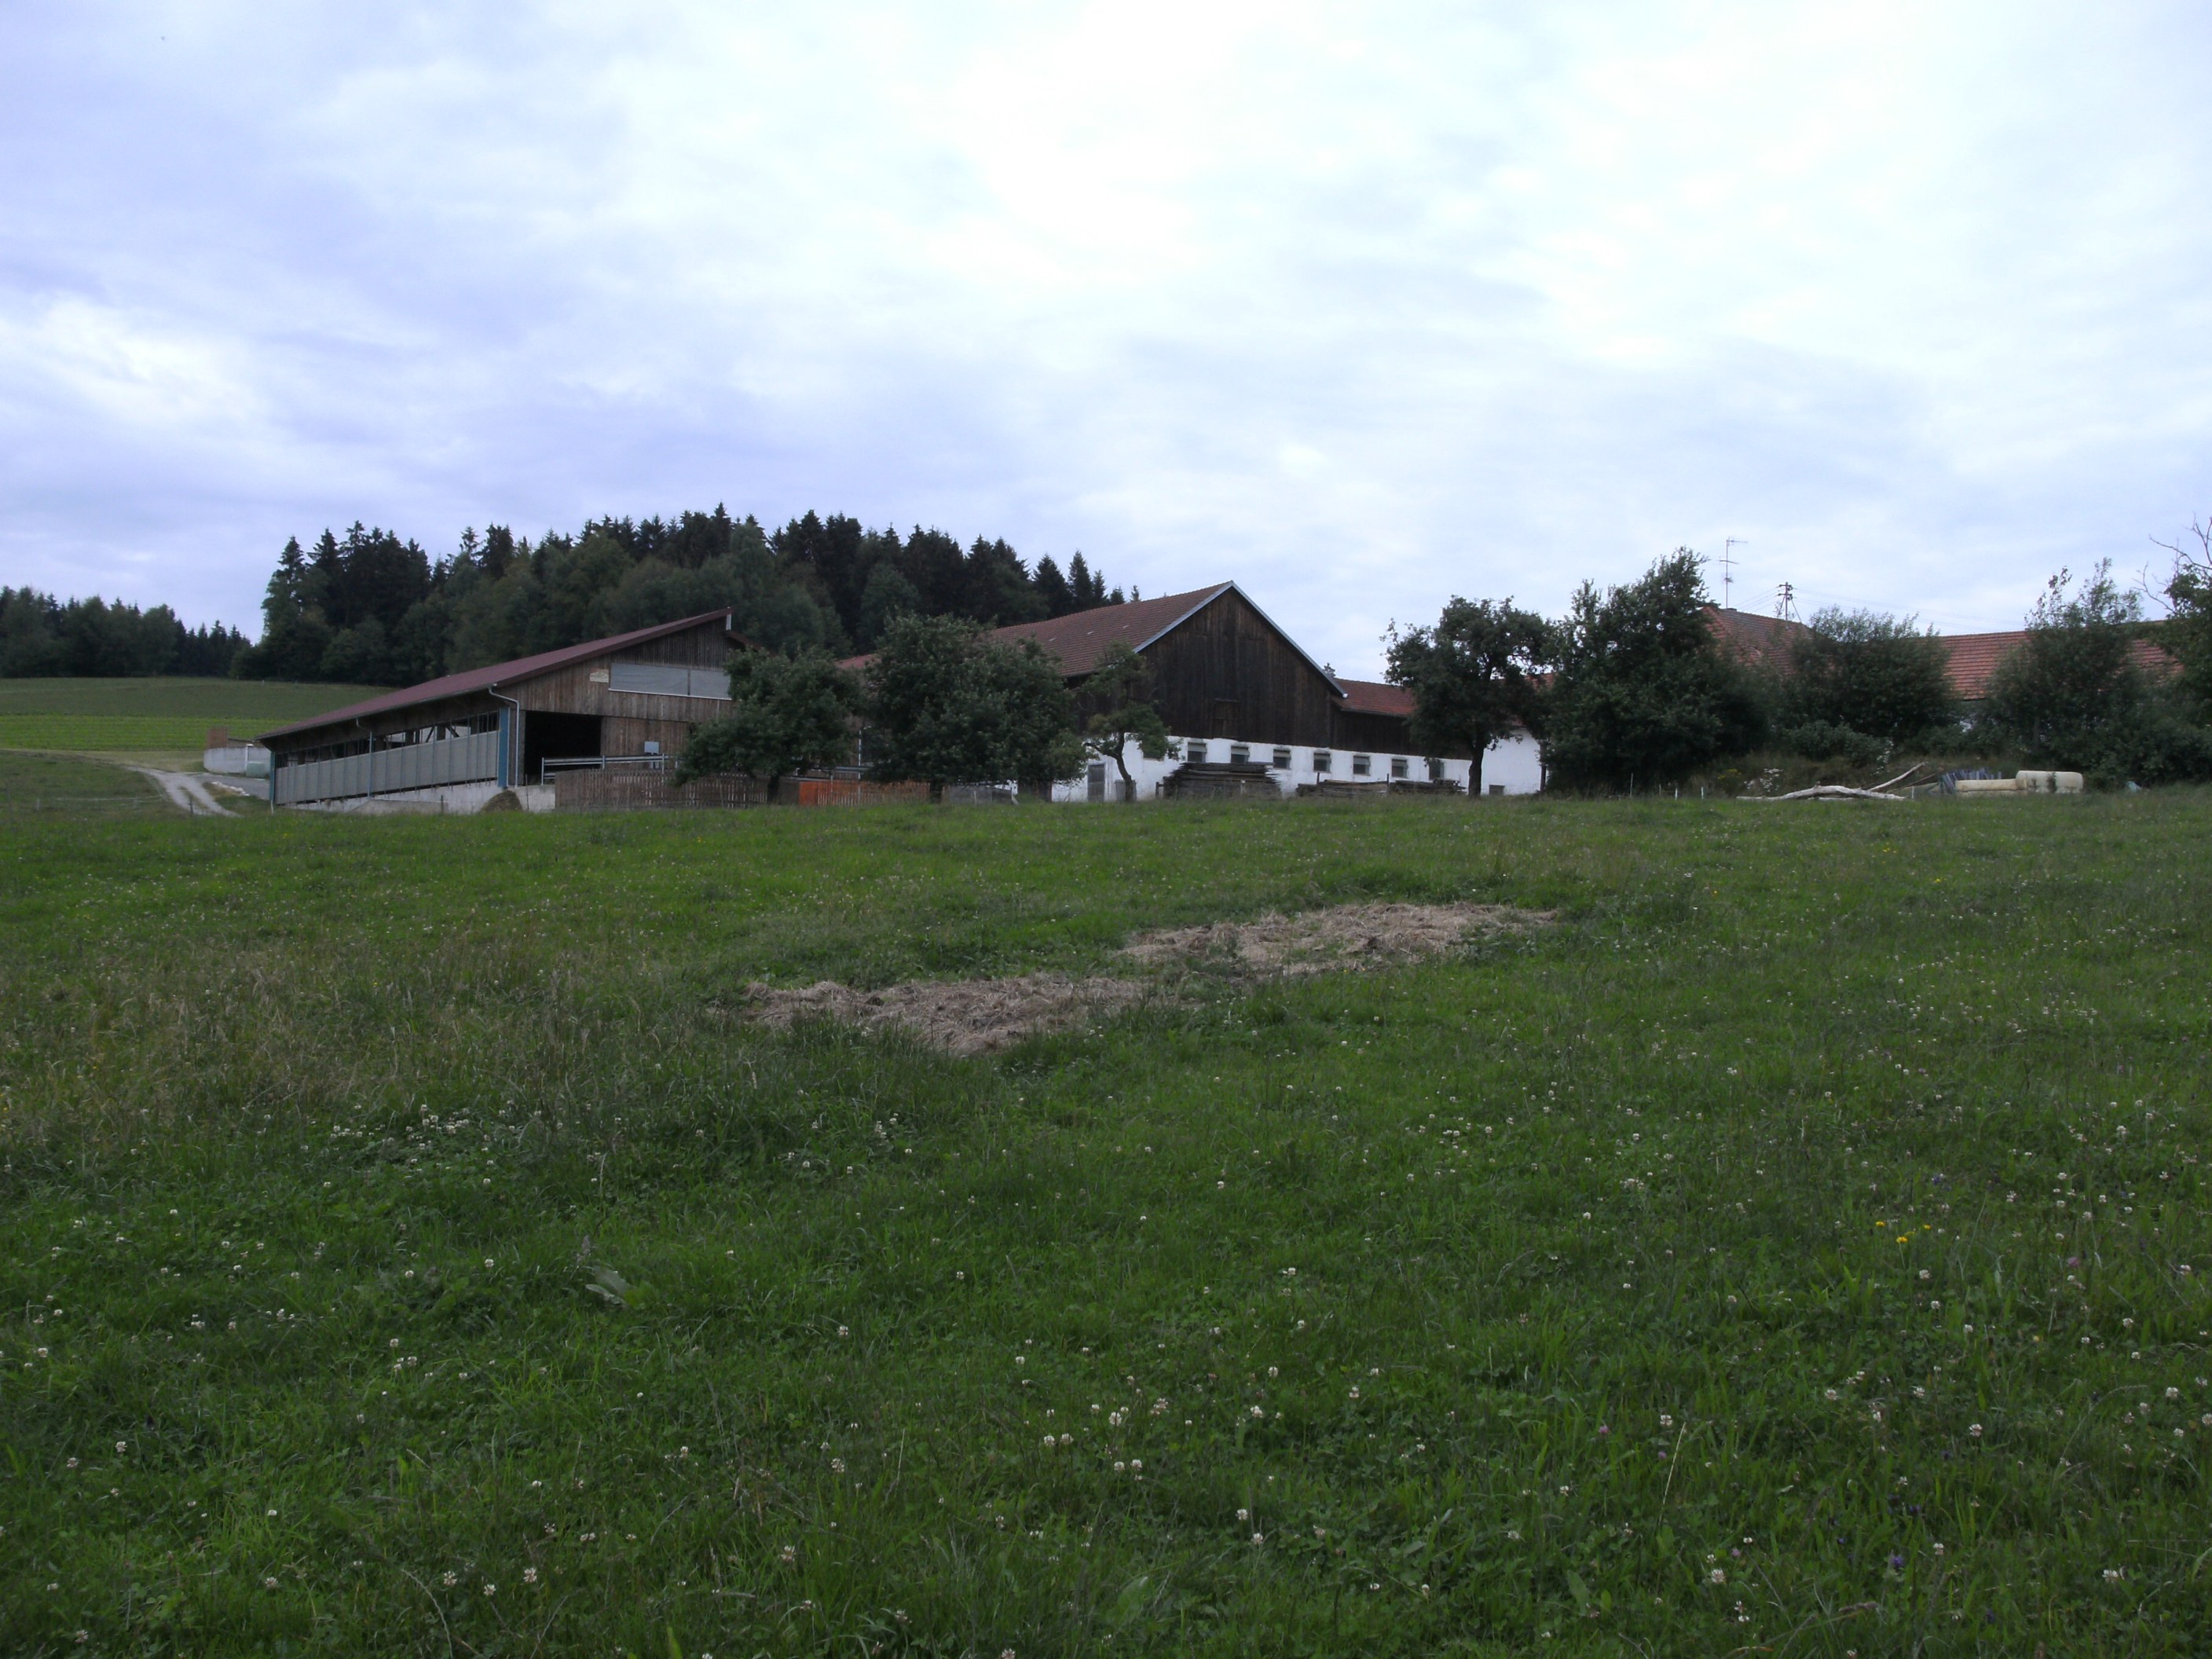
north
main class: Grassland
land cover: Grassland without tree/shrub cover
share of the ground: > 75 %
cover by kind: herbaceous plants 100 %
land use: Agriculture (excluding fallow land and kitchen gardens)
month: June
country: AT
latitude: 48.5200
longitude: 13.7501
